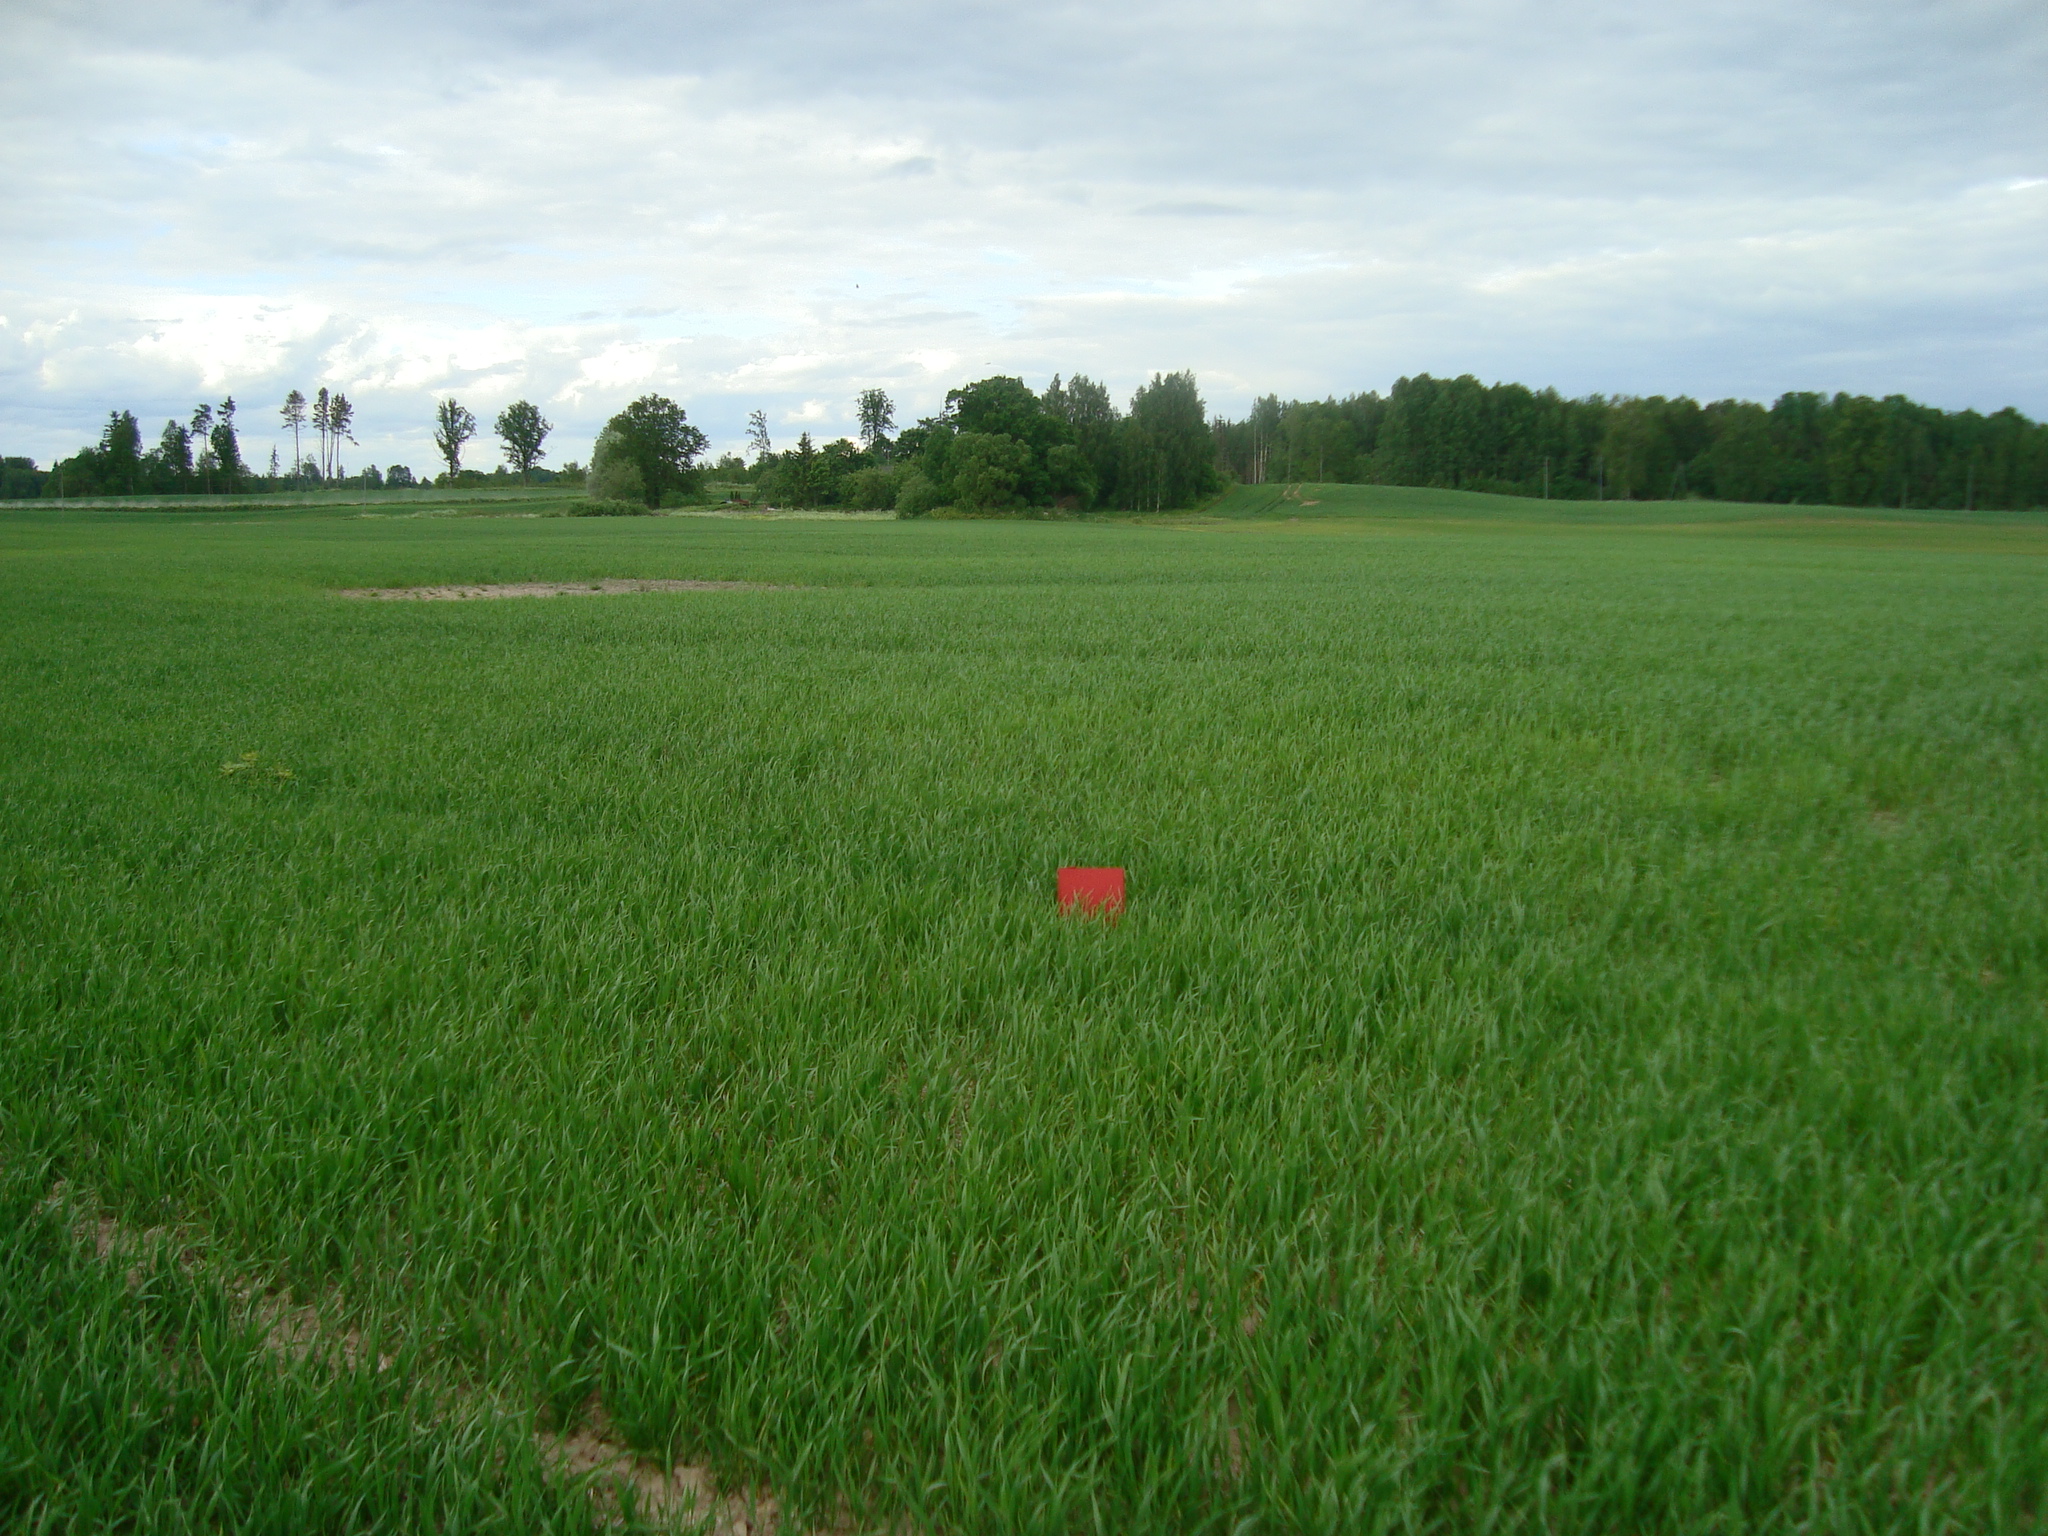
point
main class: Cropland
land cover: Barley
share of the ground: > 75 %
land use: Agriculture (excluding fallow land and kitchen gardens)
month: June
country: LV
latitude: 56.7227
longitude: 25.6639
